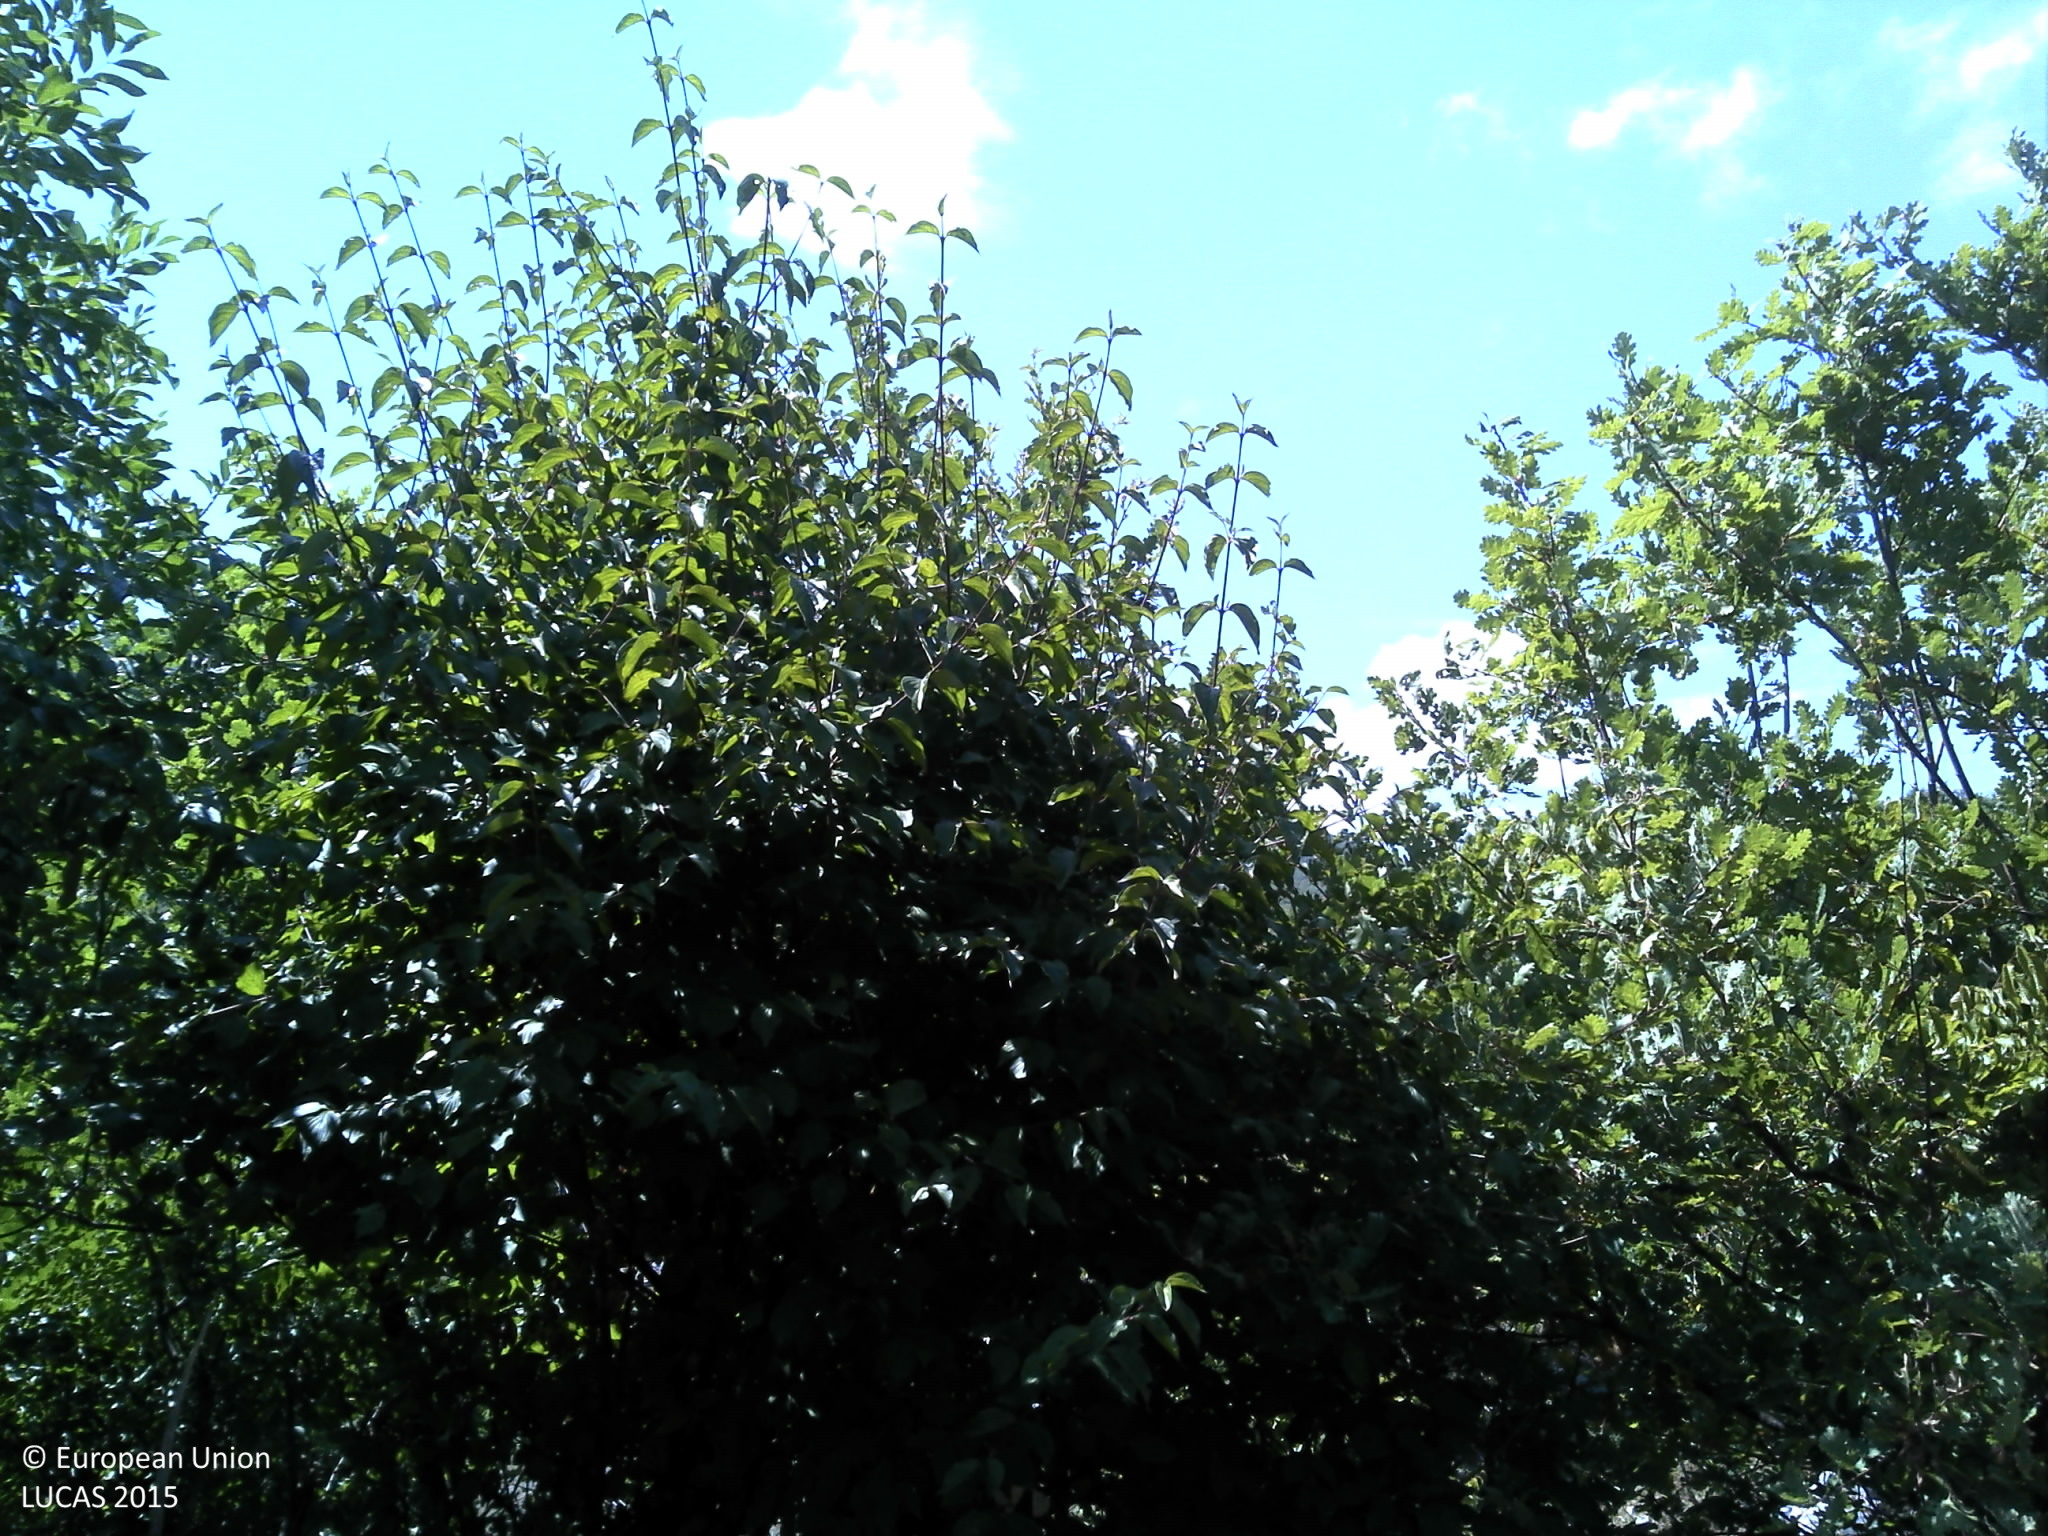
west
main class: Woodland
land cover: Broadleaved woodland
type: thermophilous deciduous forest
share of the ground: 25 - 50 %
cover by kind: broadleaved forest trees 40 %, herbaceous plants 30 %, shrubs 15 %, consolidated bare surface 10 %, unconsolidated bare surface 5 %
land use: Abandoned areas
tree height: > 5 m
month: August
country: HR
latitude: 44.1131
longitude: 15.8523
